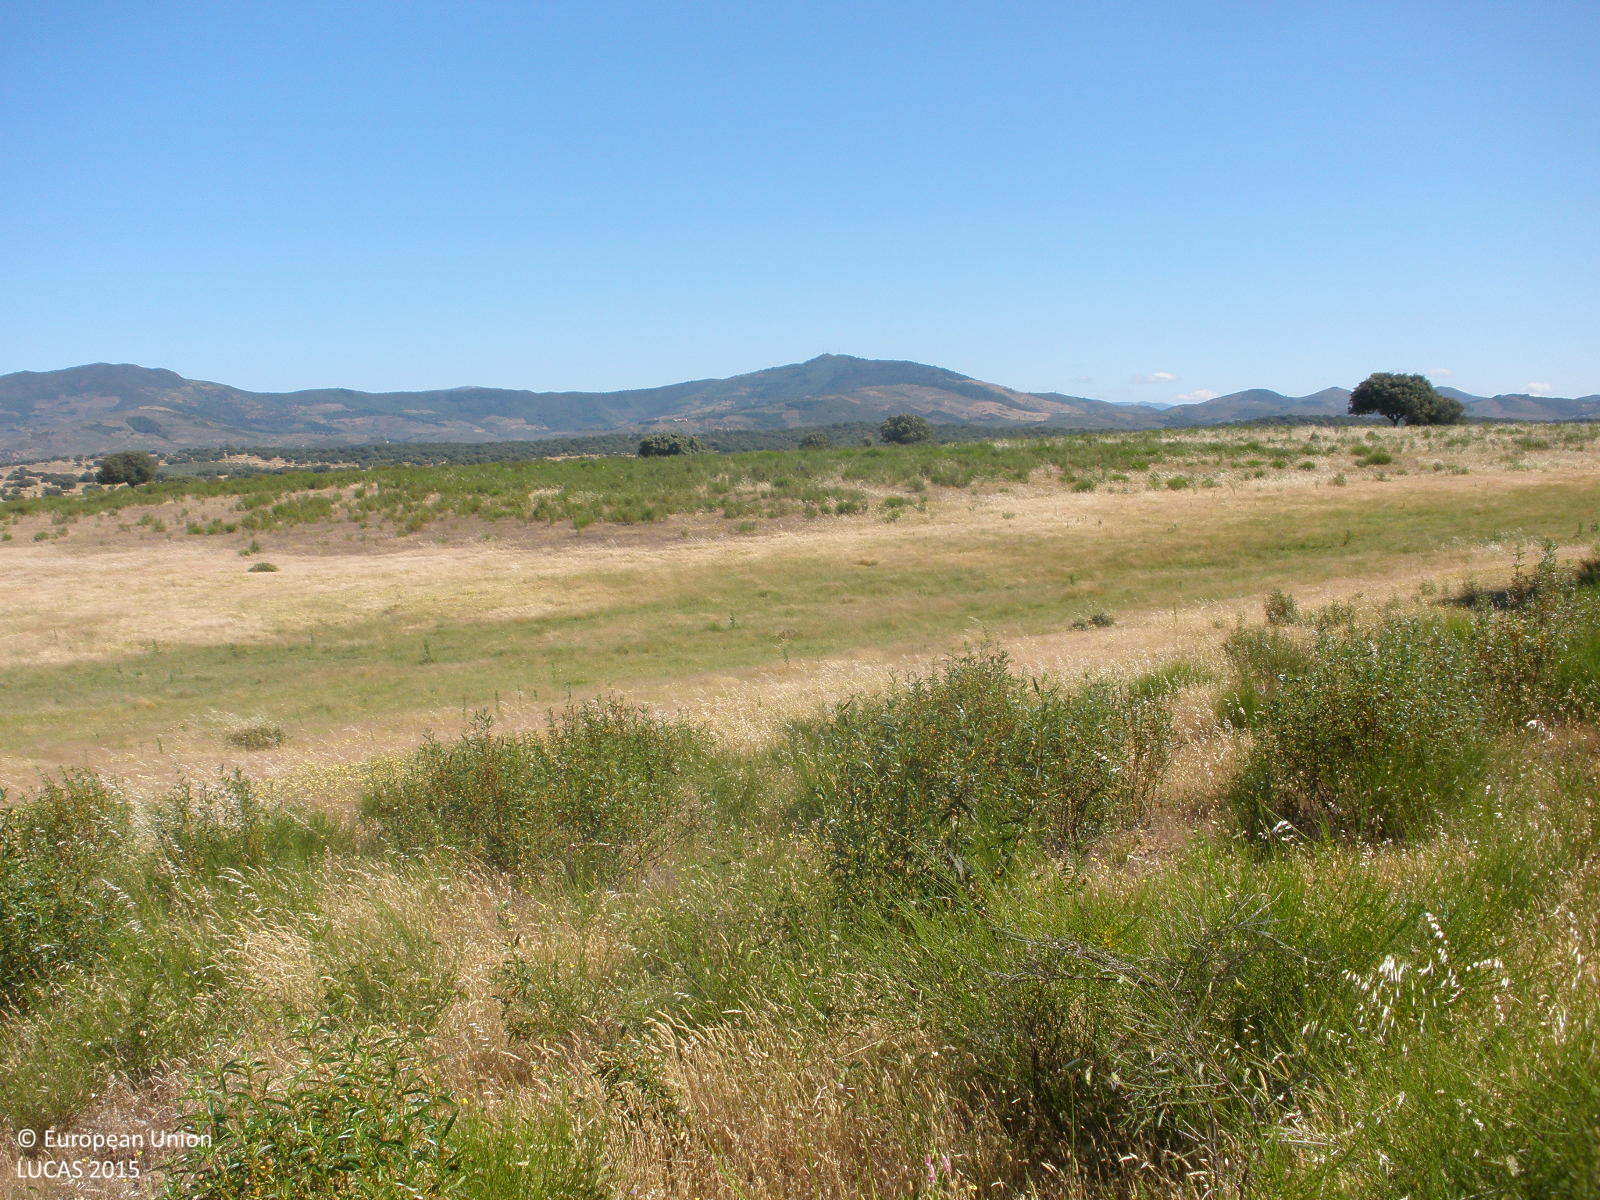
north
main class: Shrubland
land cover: Shrubland without tree cover
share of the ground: > 75 %
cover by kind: shrubs 60 %, herbaceous plants 40 %
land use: Agriculture (excluding fallow land and kitchen gardens)
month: May
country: ES
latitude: 40.2045
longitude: -6.2791
